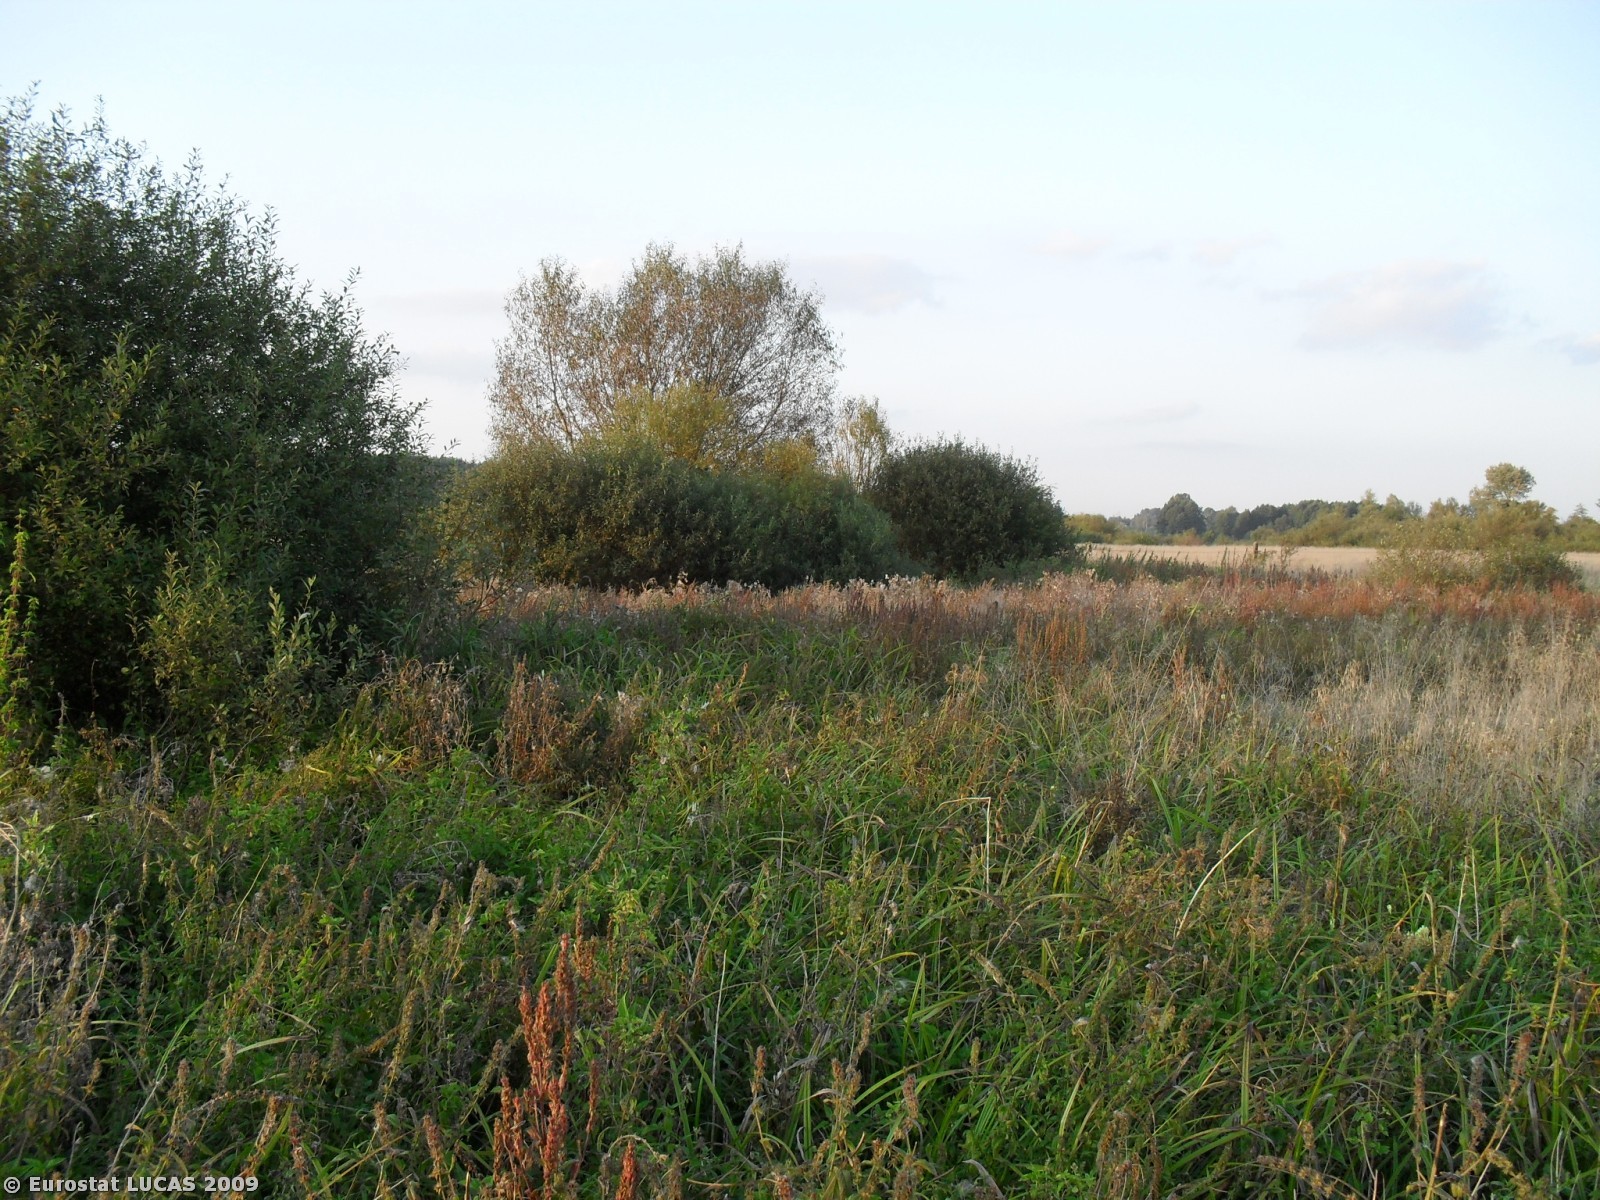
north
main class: Grassland
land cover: Grassland without tree/shrub cover
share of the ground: > 75 %
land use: Unused
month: September
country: PL
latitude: 51.6091
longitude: 20.6244
